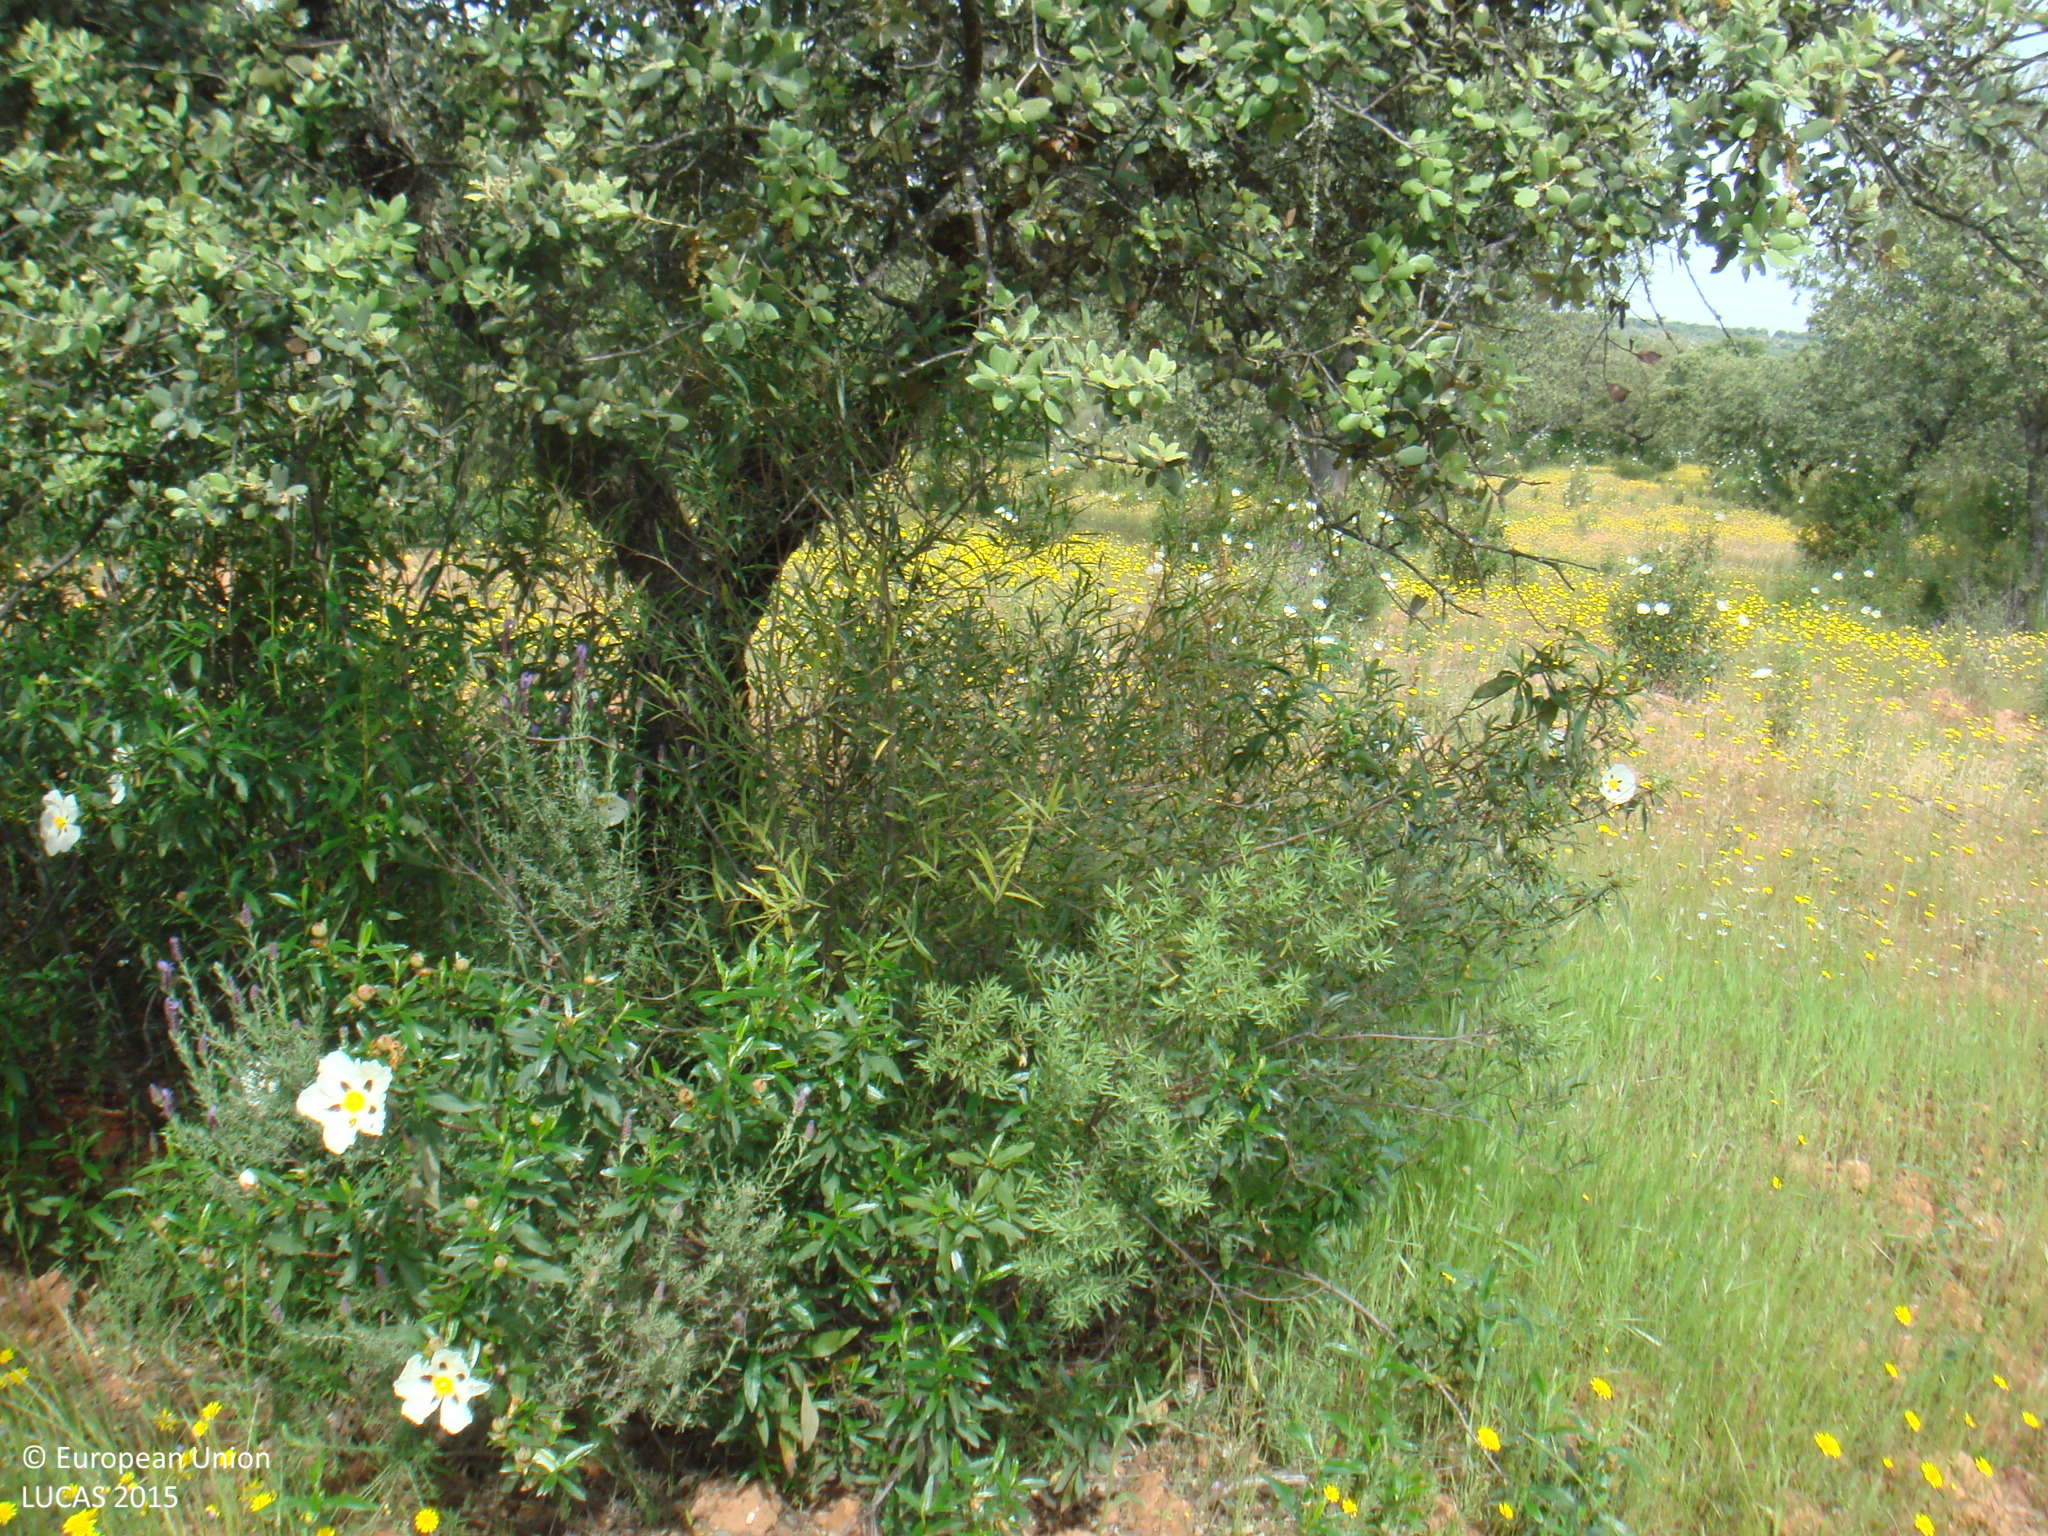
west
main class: Woodland
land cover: Broadleaved woodland
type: broadleaved evergreen forest
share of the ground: 25 - 50 %
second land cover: Shrubland without tree cover
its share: 25 - 50 %
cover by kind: herbaceous plants 50 %, shrubs 30 %, broadleaved forest trees 20 %
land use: Forestry
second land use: Agriculture (excluding fallow land and kitchen gardens)
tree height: > 5 m
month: May
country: ES
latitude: 38.3526
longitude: -5.1204
